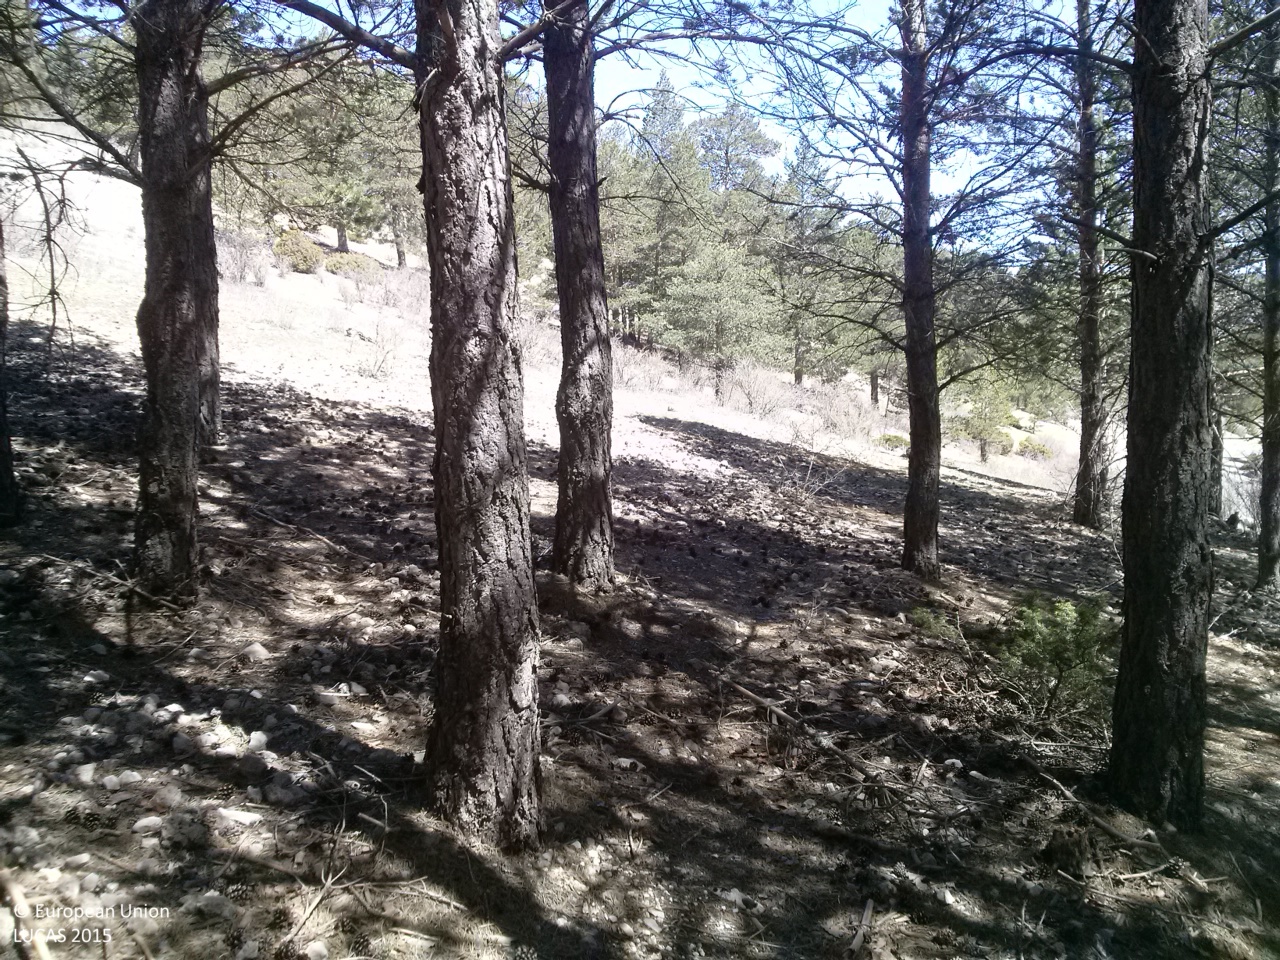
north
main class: Woodland
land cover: Pine dominated coniferous woodland
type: coniferous forest of the mediterranean region
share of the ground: > 75 %
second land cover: Grassland without tree/shrub cover
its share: 50 - 75 %
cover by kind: coniferous forest trees 75 %, herbaceous plants 15 %, shrubs 5 %, unconsolidated bare surface 5 %
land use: Forestry
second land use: Agriculture (excluding fallow land and kitchen gardens)
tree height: > 5 m
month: April
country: ES
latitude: 40.3436
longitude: -1.7527
